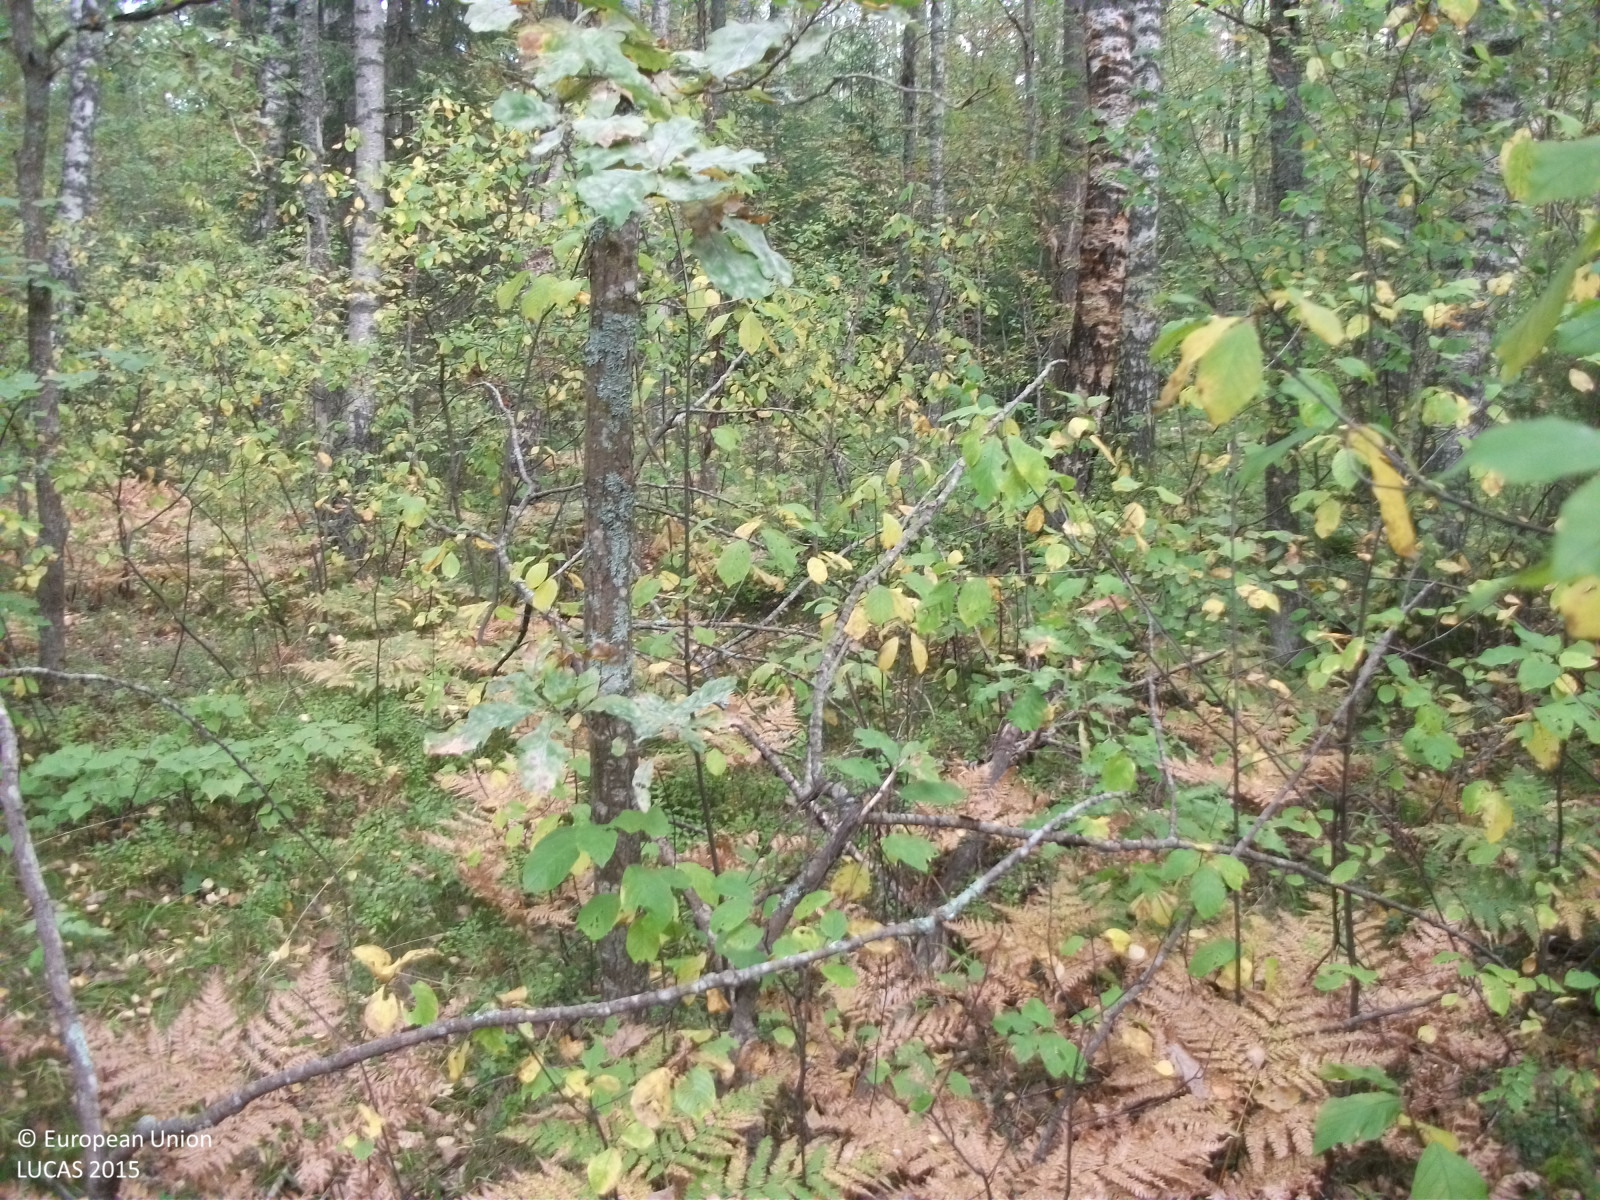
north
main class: Woodland
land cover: Broadleaved woodland
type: non-riverine alder, birch or aspen forest
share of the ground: > 75 %
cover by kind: broadleaved forest trees 85 %, coniferous forest trees 5 %, shrubs 5 %, herbaceous plants 5 %
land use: Forestry
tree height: > 5 m
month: September
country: LV
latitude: 57.8667
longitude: 24.5014
